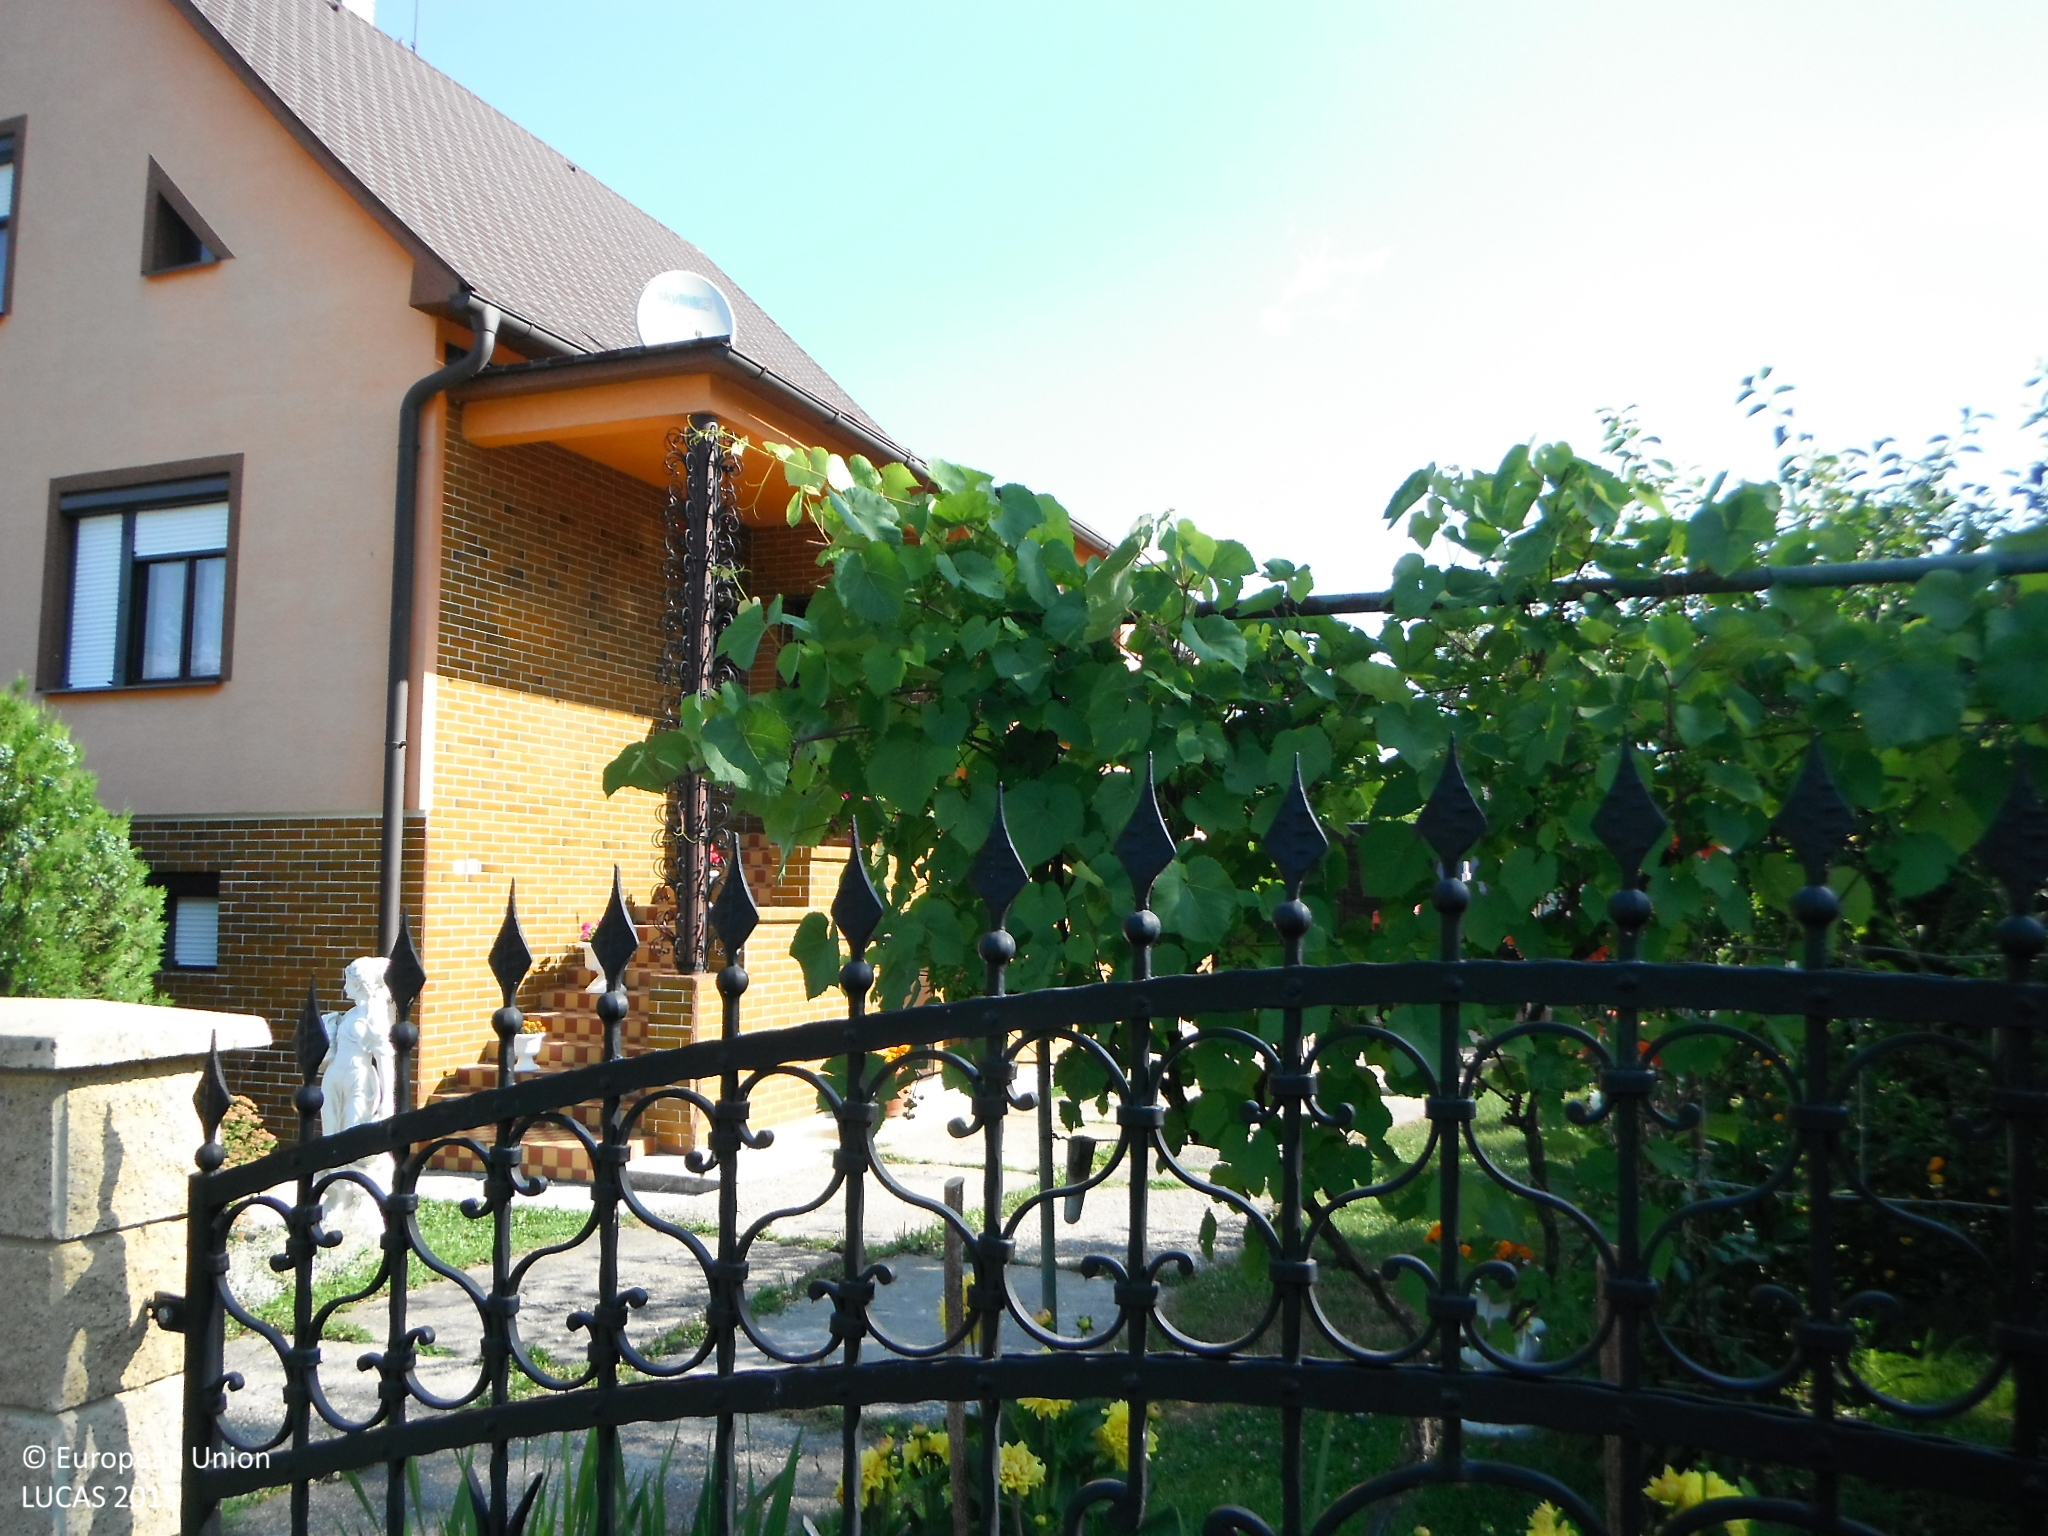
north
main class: Cropland
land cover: Vineyards
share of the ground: > 75 %
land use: Kitchen garden
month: July
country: SK
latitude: 48.6525
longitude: 18.5286
